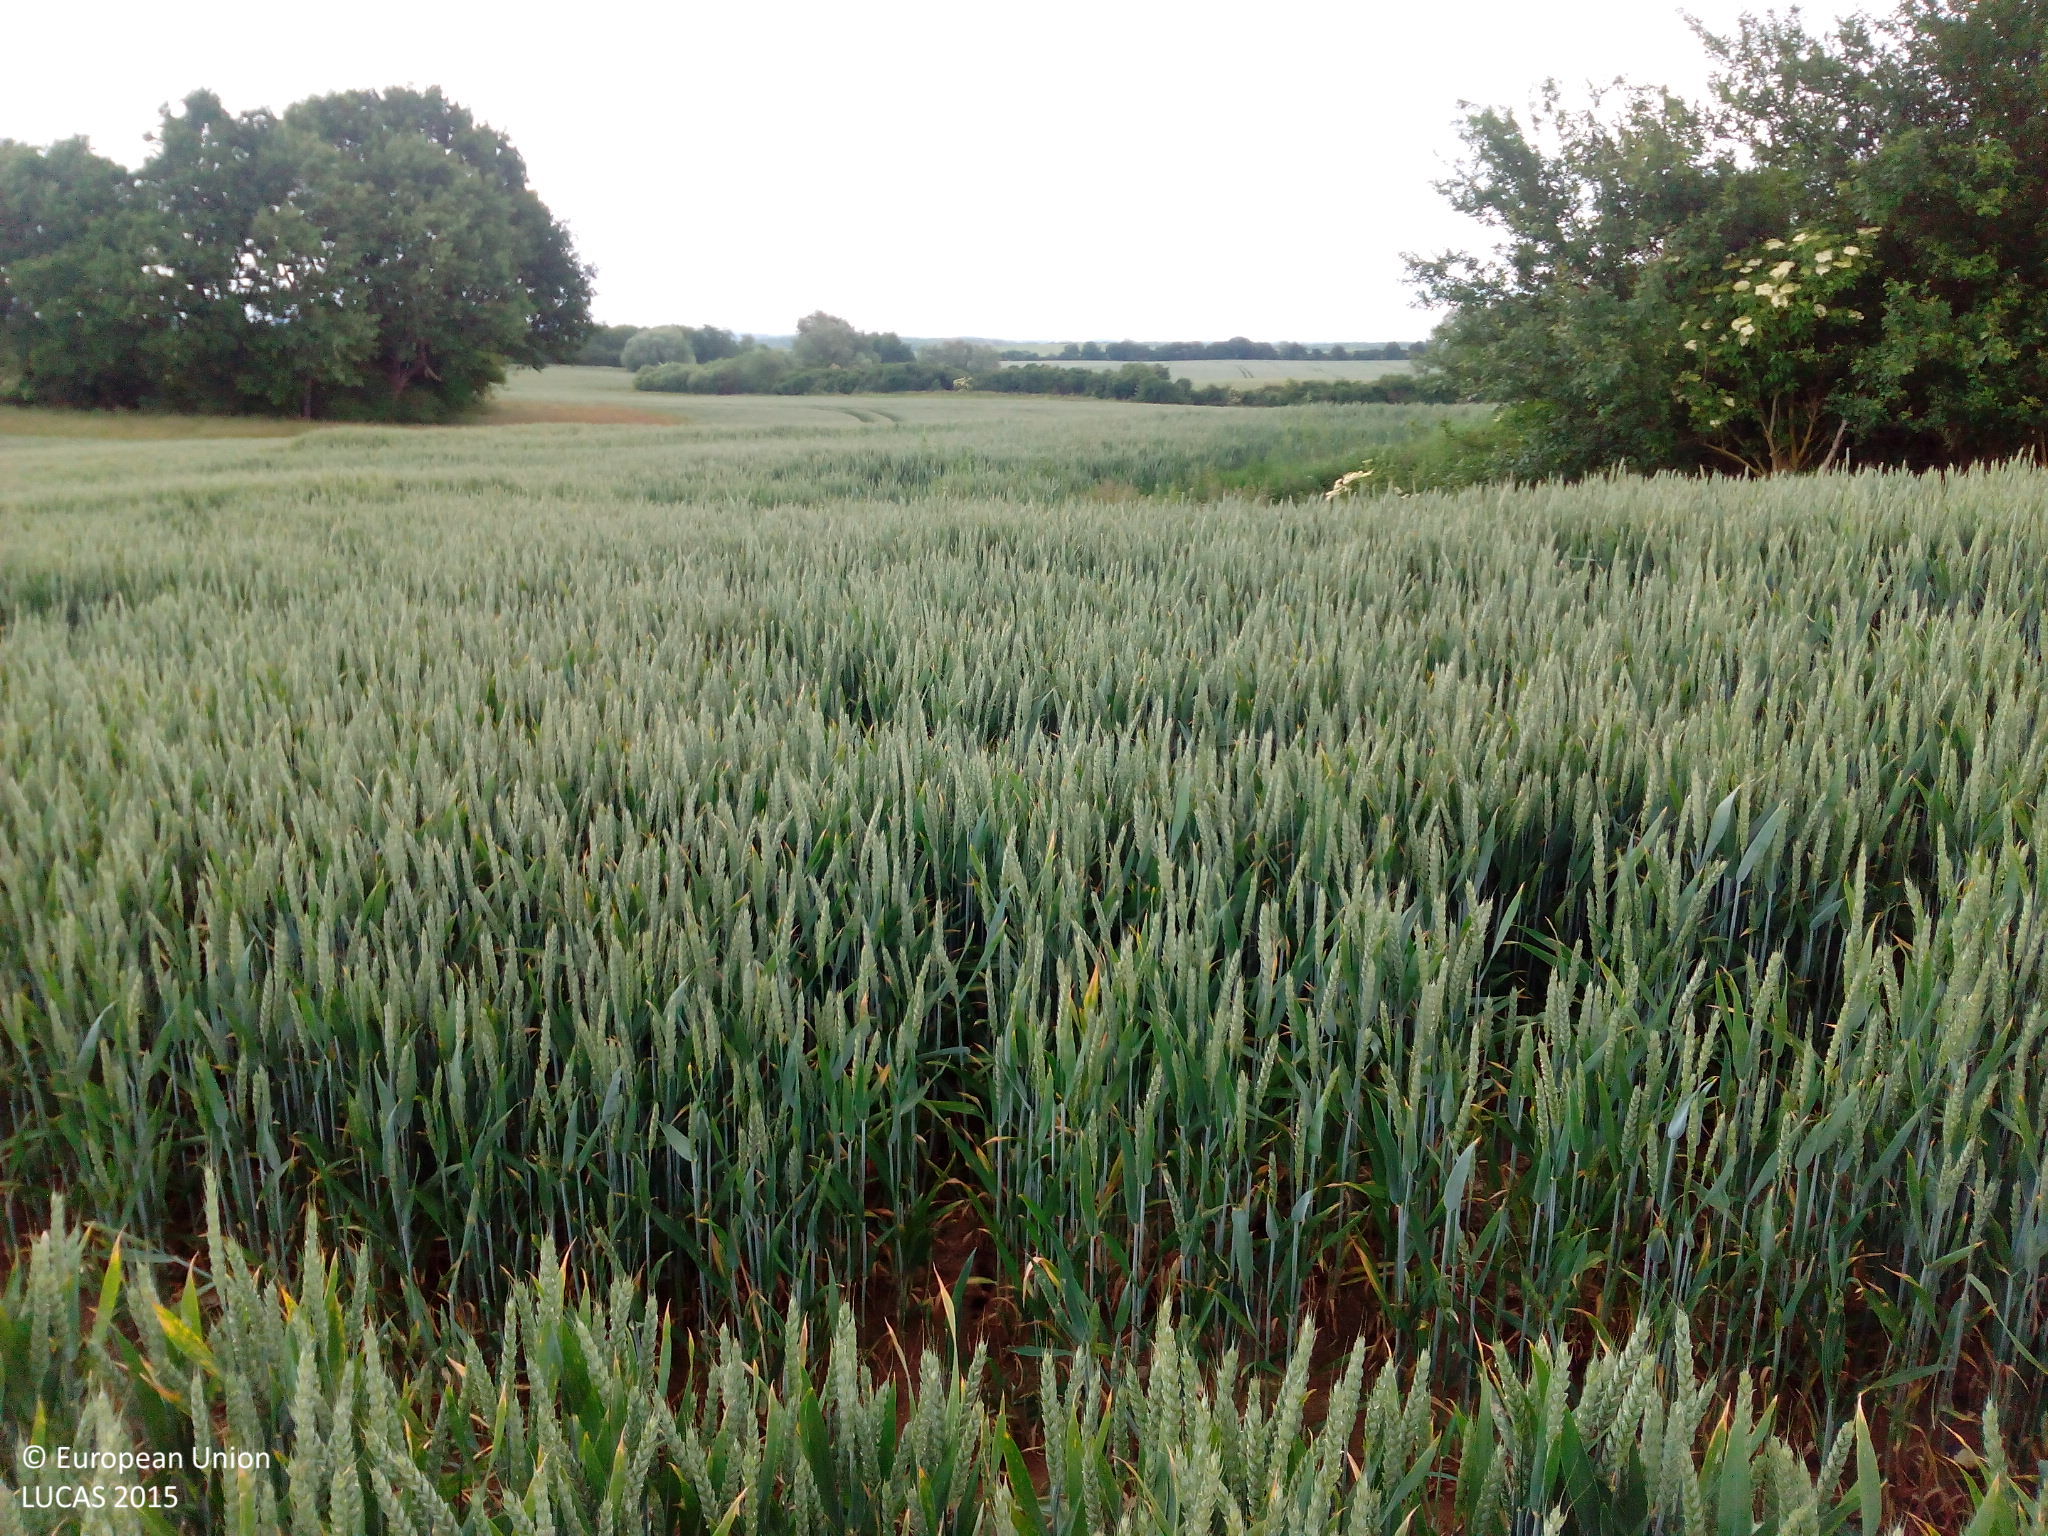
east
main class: Cropland
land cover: Common wheat
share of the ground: > 75 %
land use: Agriculture (excluding fallow land and kitchen gardens)
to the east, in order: Common wheat; Grassland without tree/shrub cover
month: June
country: DE
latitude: 53.7917
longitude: 11.1683
